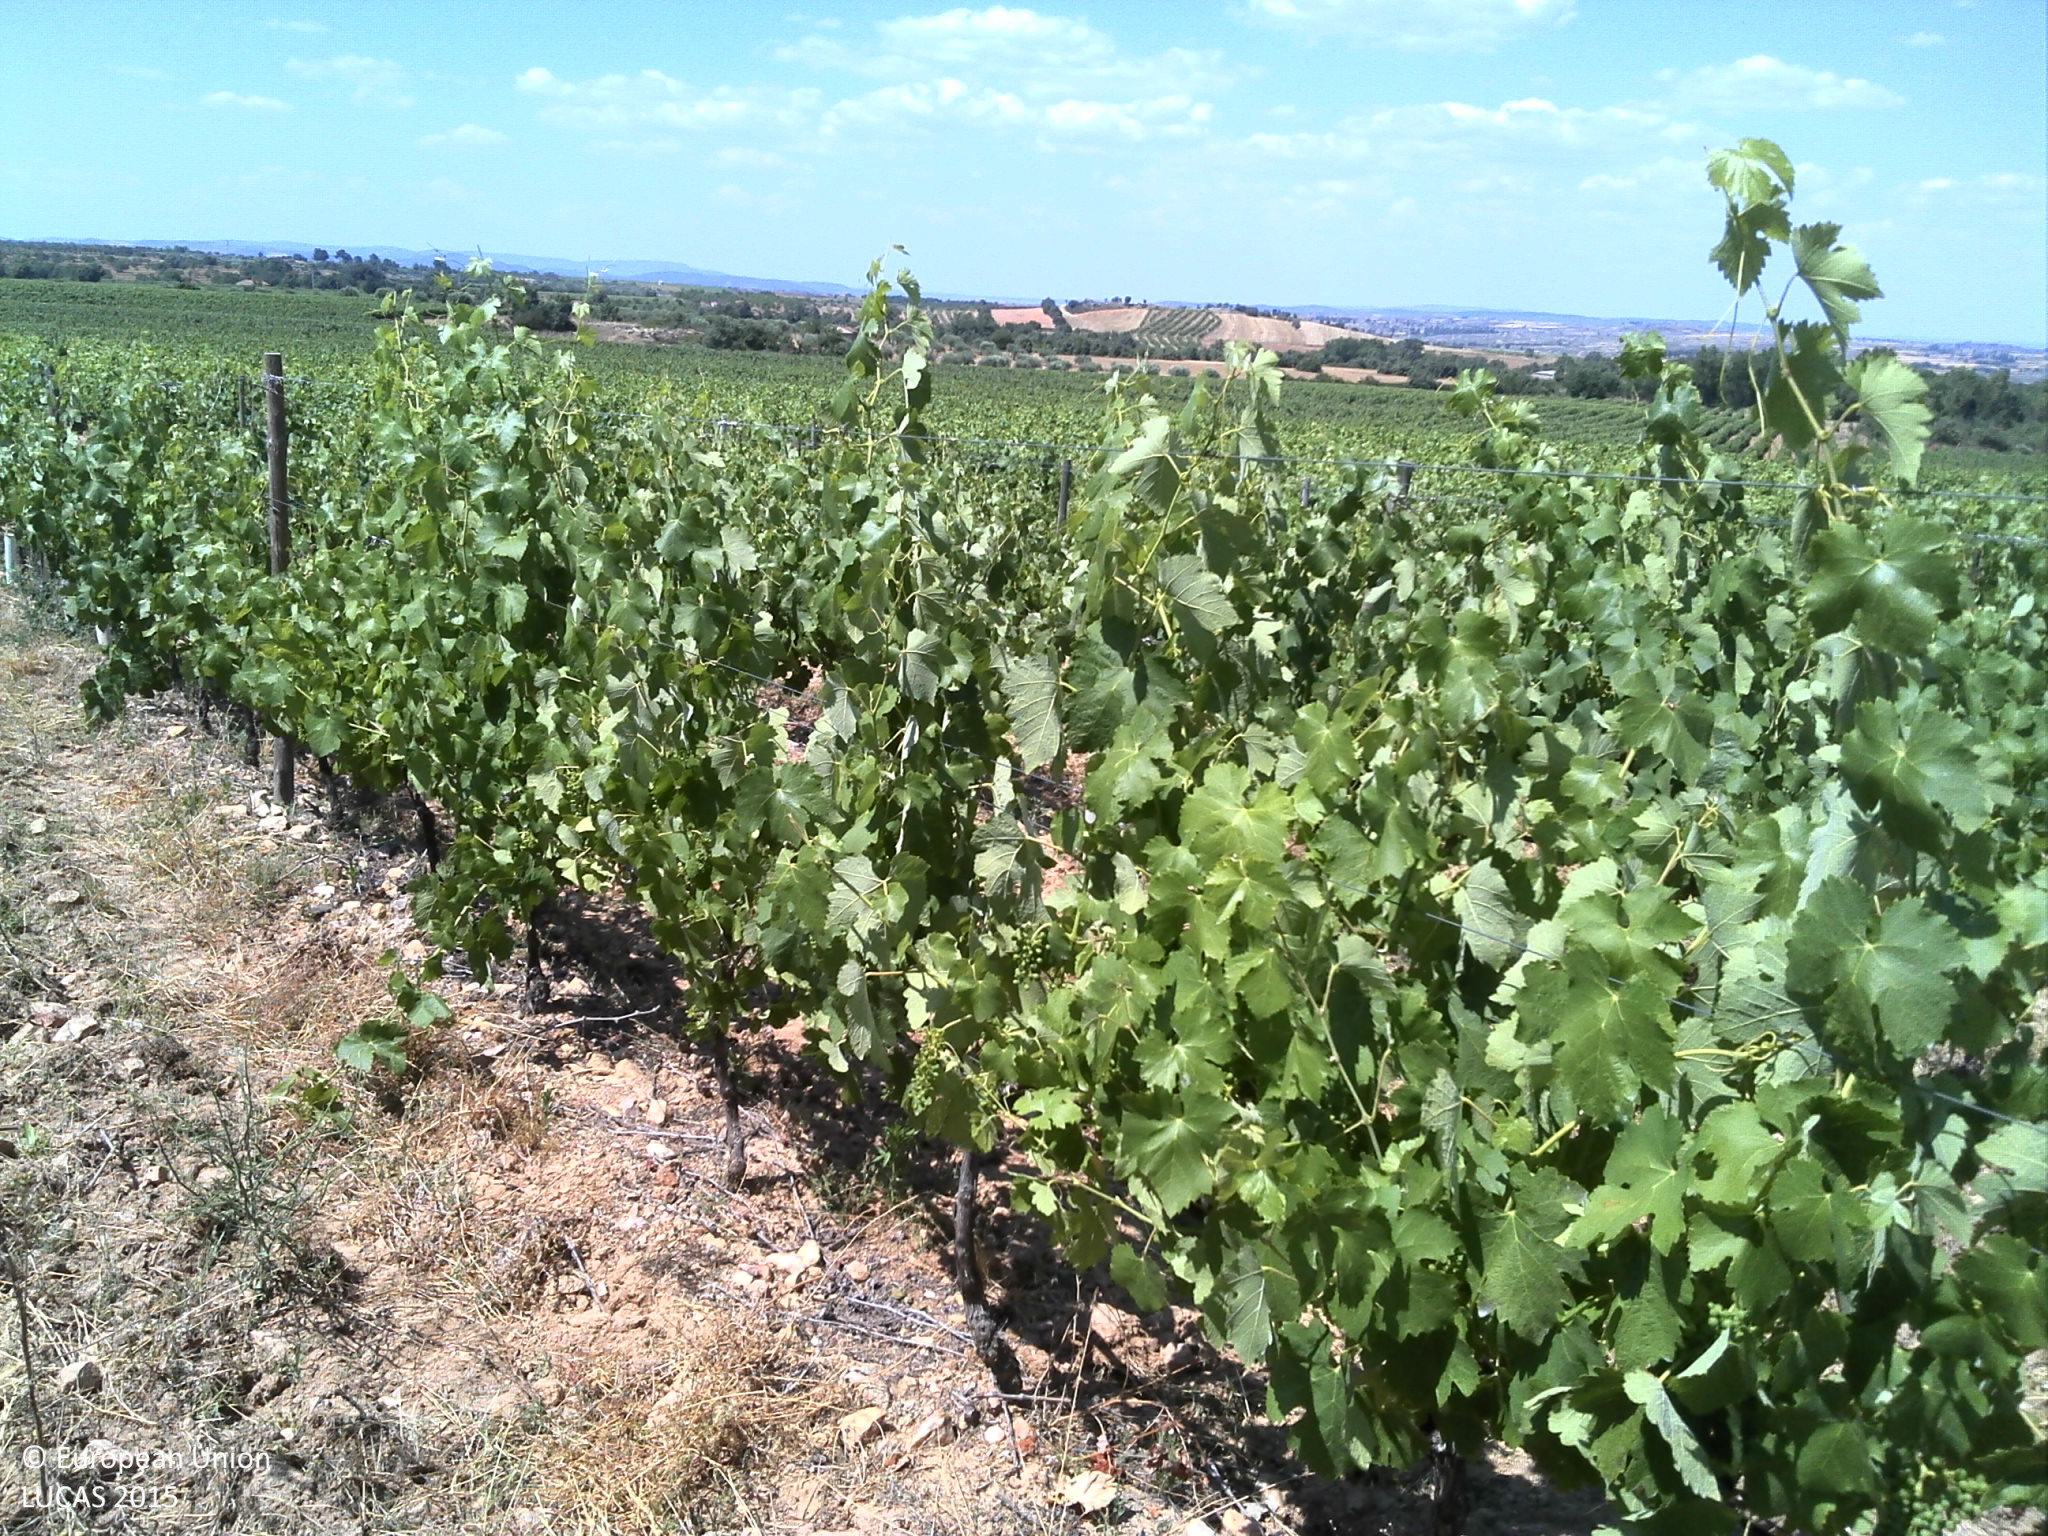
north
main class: Cropland
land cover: Vineyards
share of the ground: < 10 %
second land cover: Grassland without tree/shrub cover
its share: 50 - 75 %
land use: Agriculture (excluding fallow land and kitchen gardens)
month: June
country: PT
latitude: 40.8827
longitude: -6.9436
